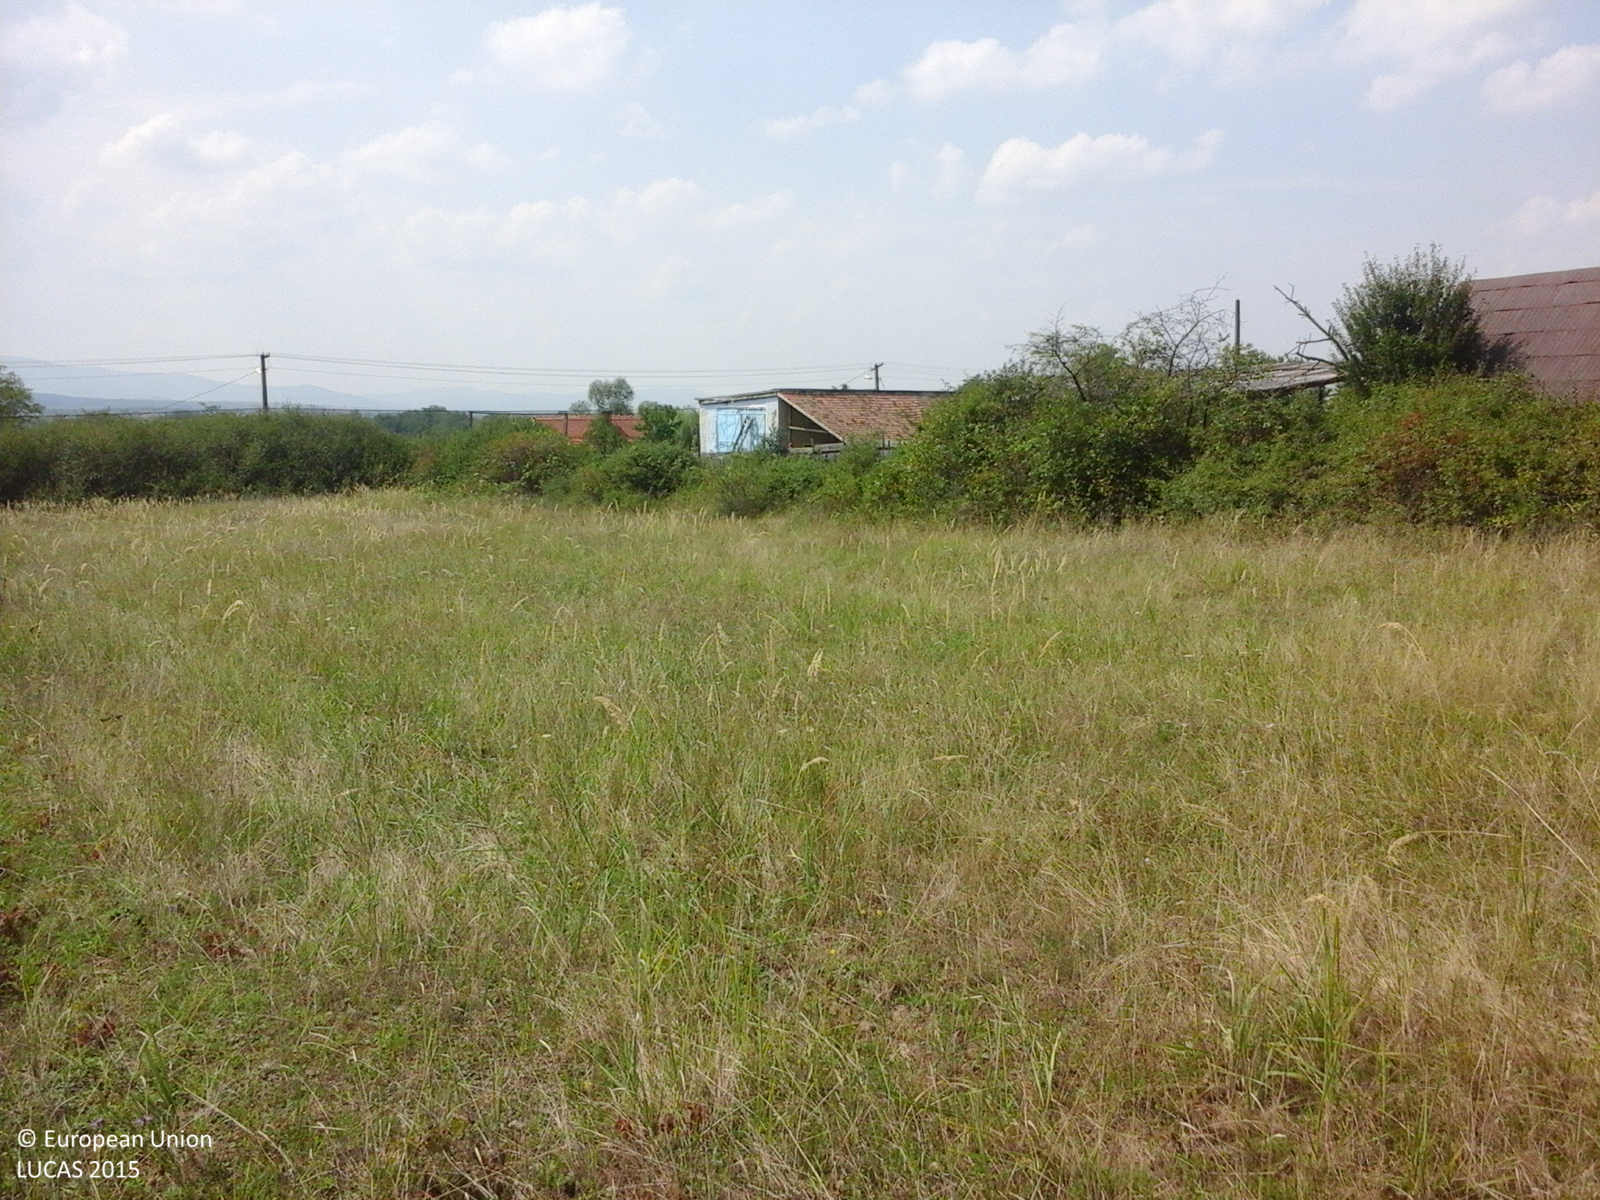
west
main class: Grassland
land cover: Grassland without tree/shrub cover
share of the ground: > 75 %
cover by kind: herbaceous plants 100 %
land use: Agriculture (excluding fallow land and kitchen gardens)
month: August
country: RO
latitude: 46.3361
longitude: 21.9295
